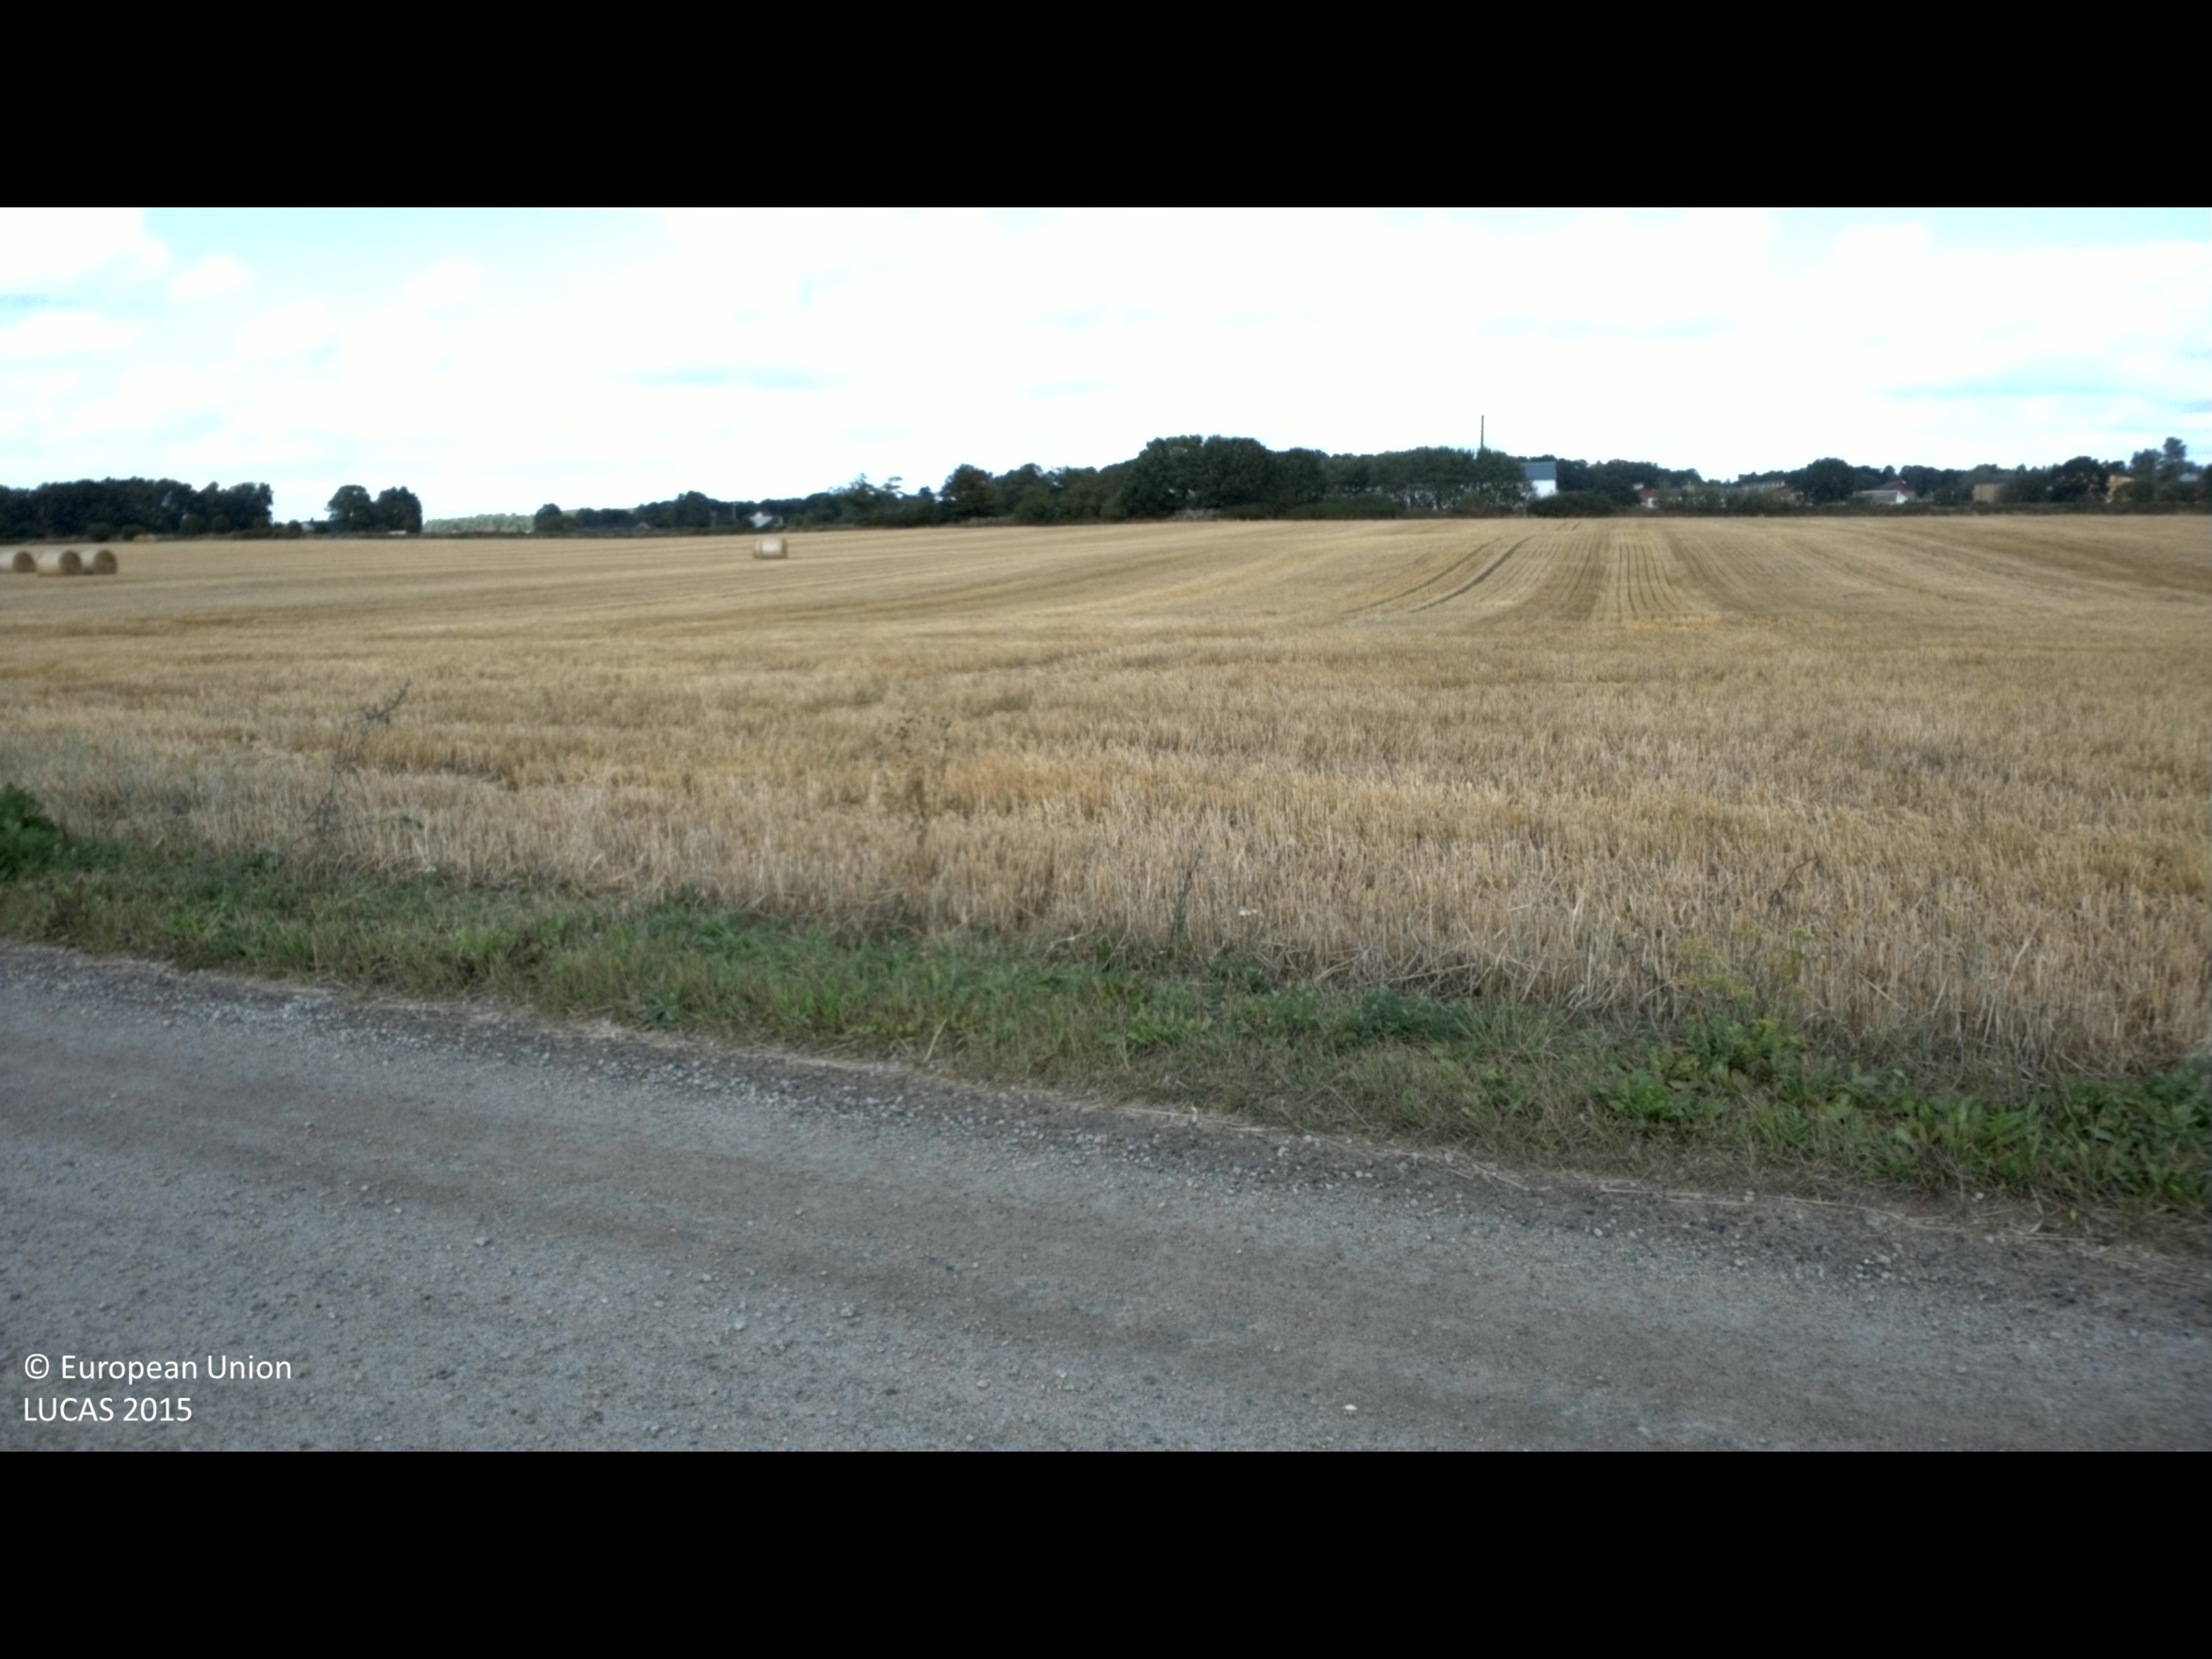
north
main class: Cropland
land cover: Sugar beet
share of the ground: > 75 %
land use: Agriculture (excluding fallow land and kitchen gardens)
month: September
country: SE
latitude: 56.1026
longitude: 14.6769
